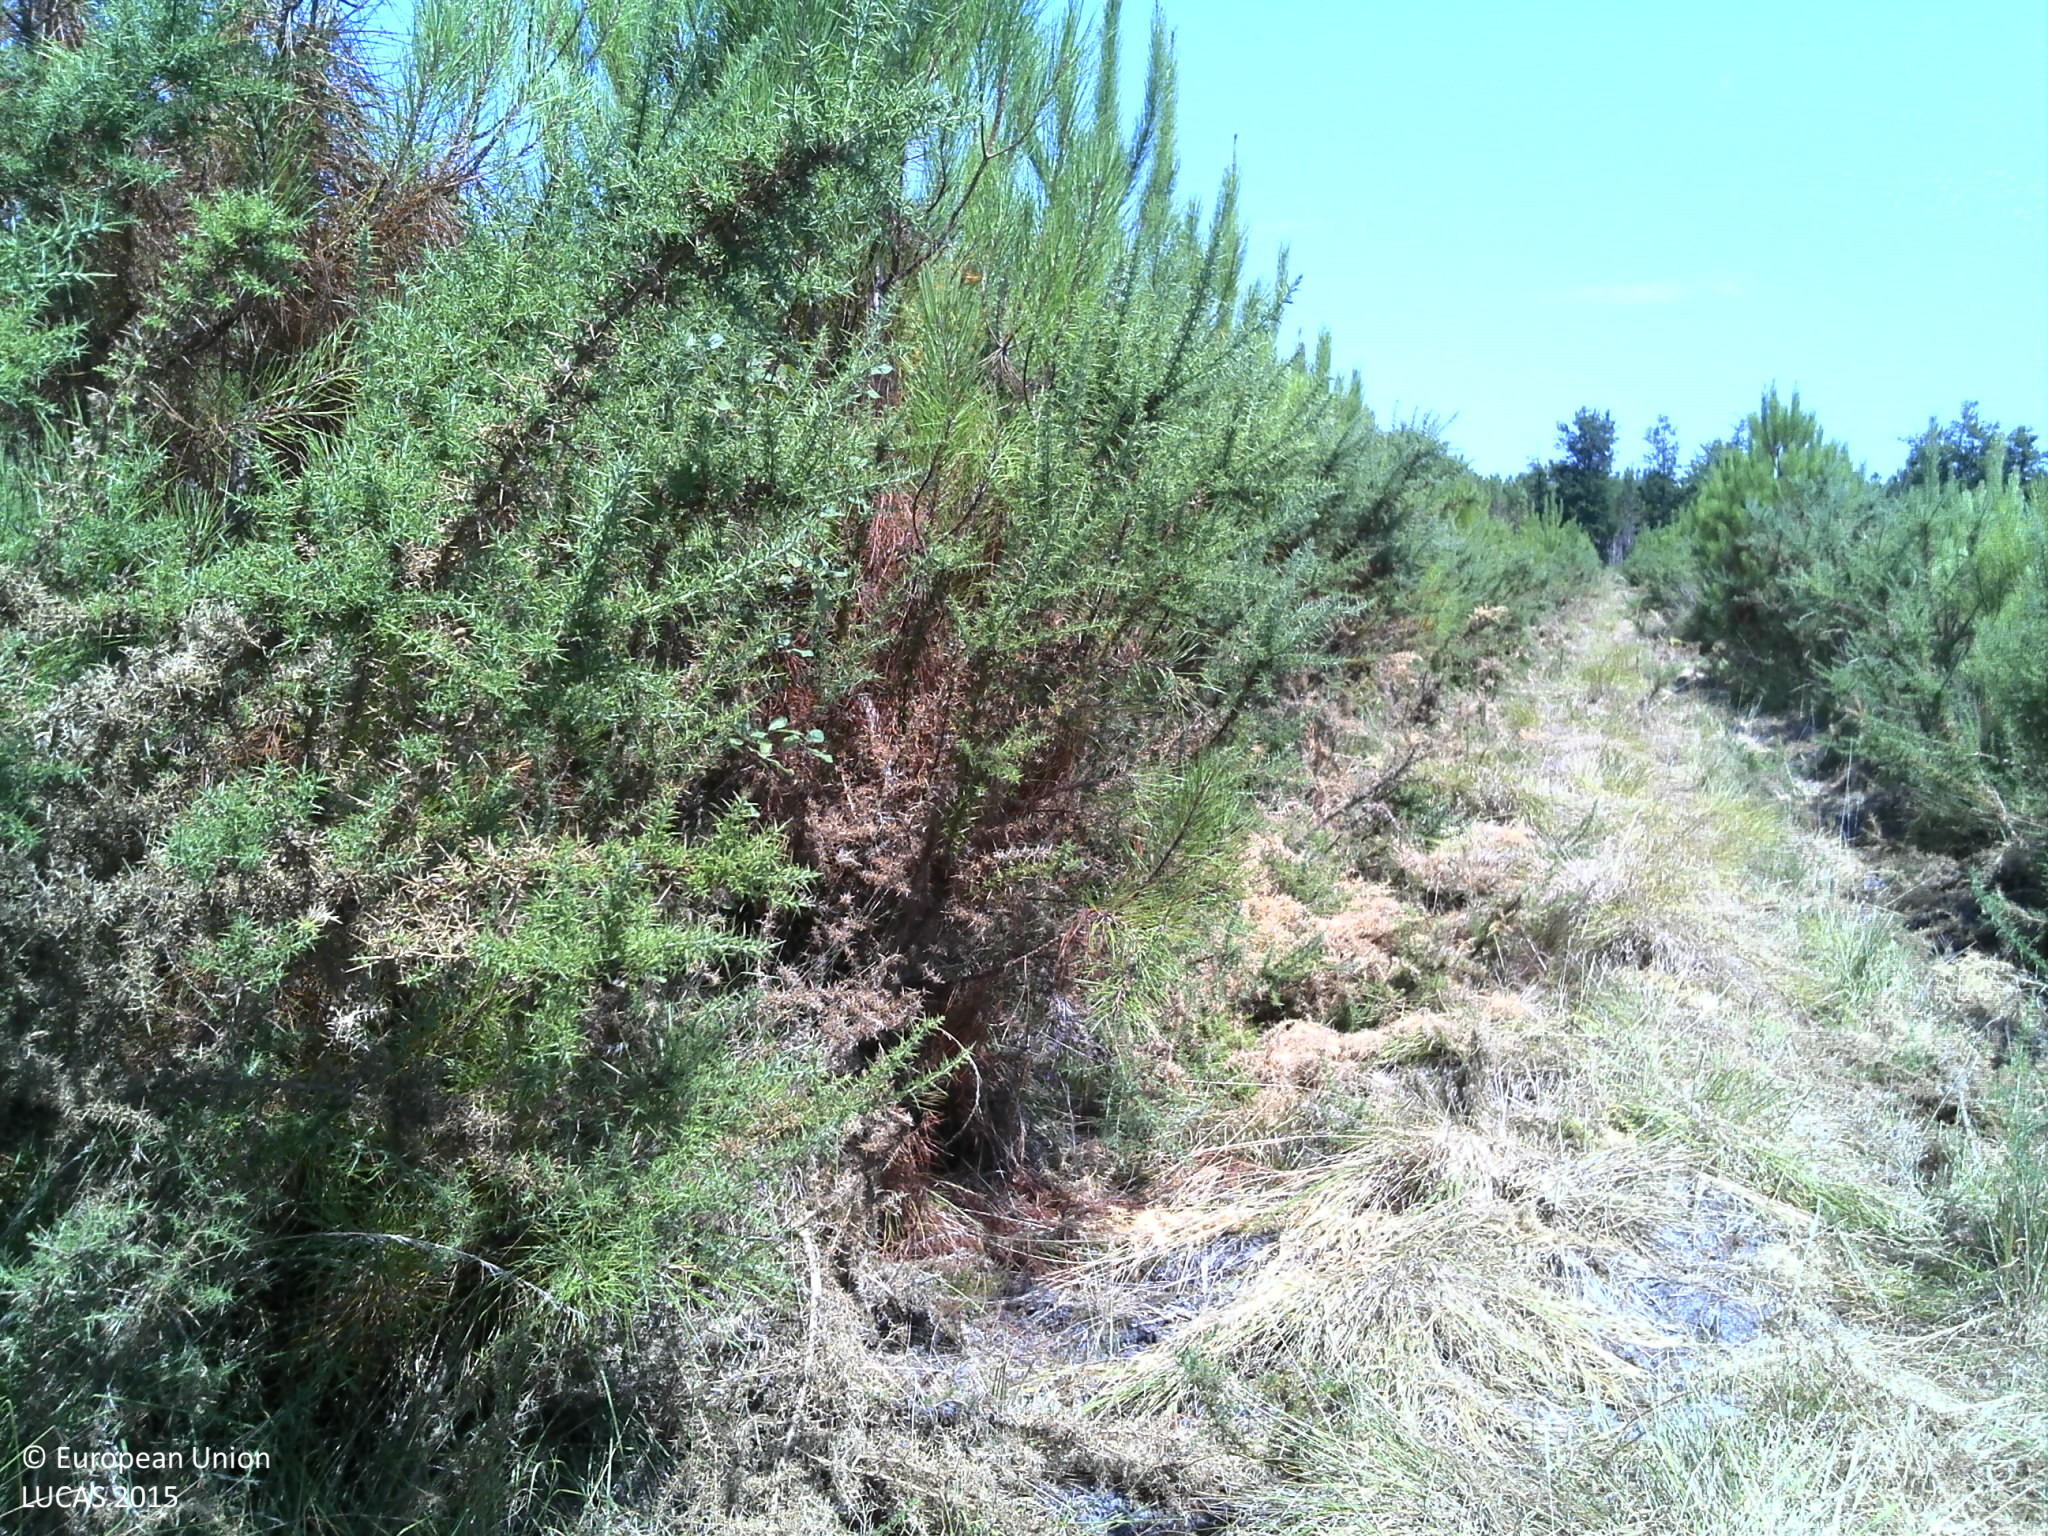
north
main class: Woodland
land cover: Pine dominated coniferous woodland
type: coniferous forest of the mediterranean region
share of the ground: > 75 %
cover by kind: coniferous forest trees 60 %, shrubs 30 %, herbaceous plants 5 %, lichens and mosses 5 %
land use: Forestry
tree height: < 5 m
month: August
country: FR
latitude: 44.9982
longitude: -1.0222
